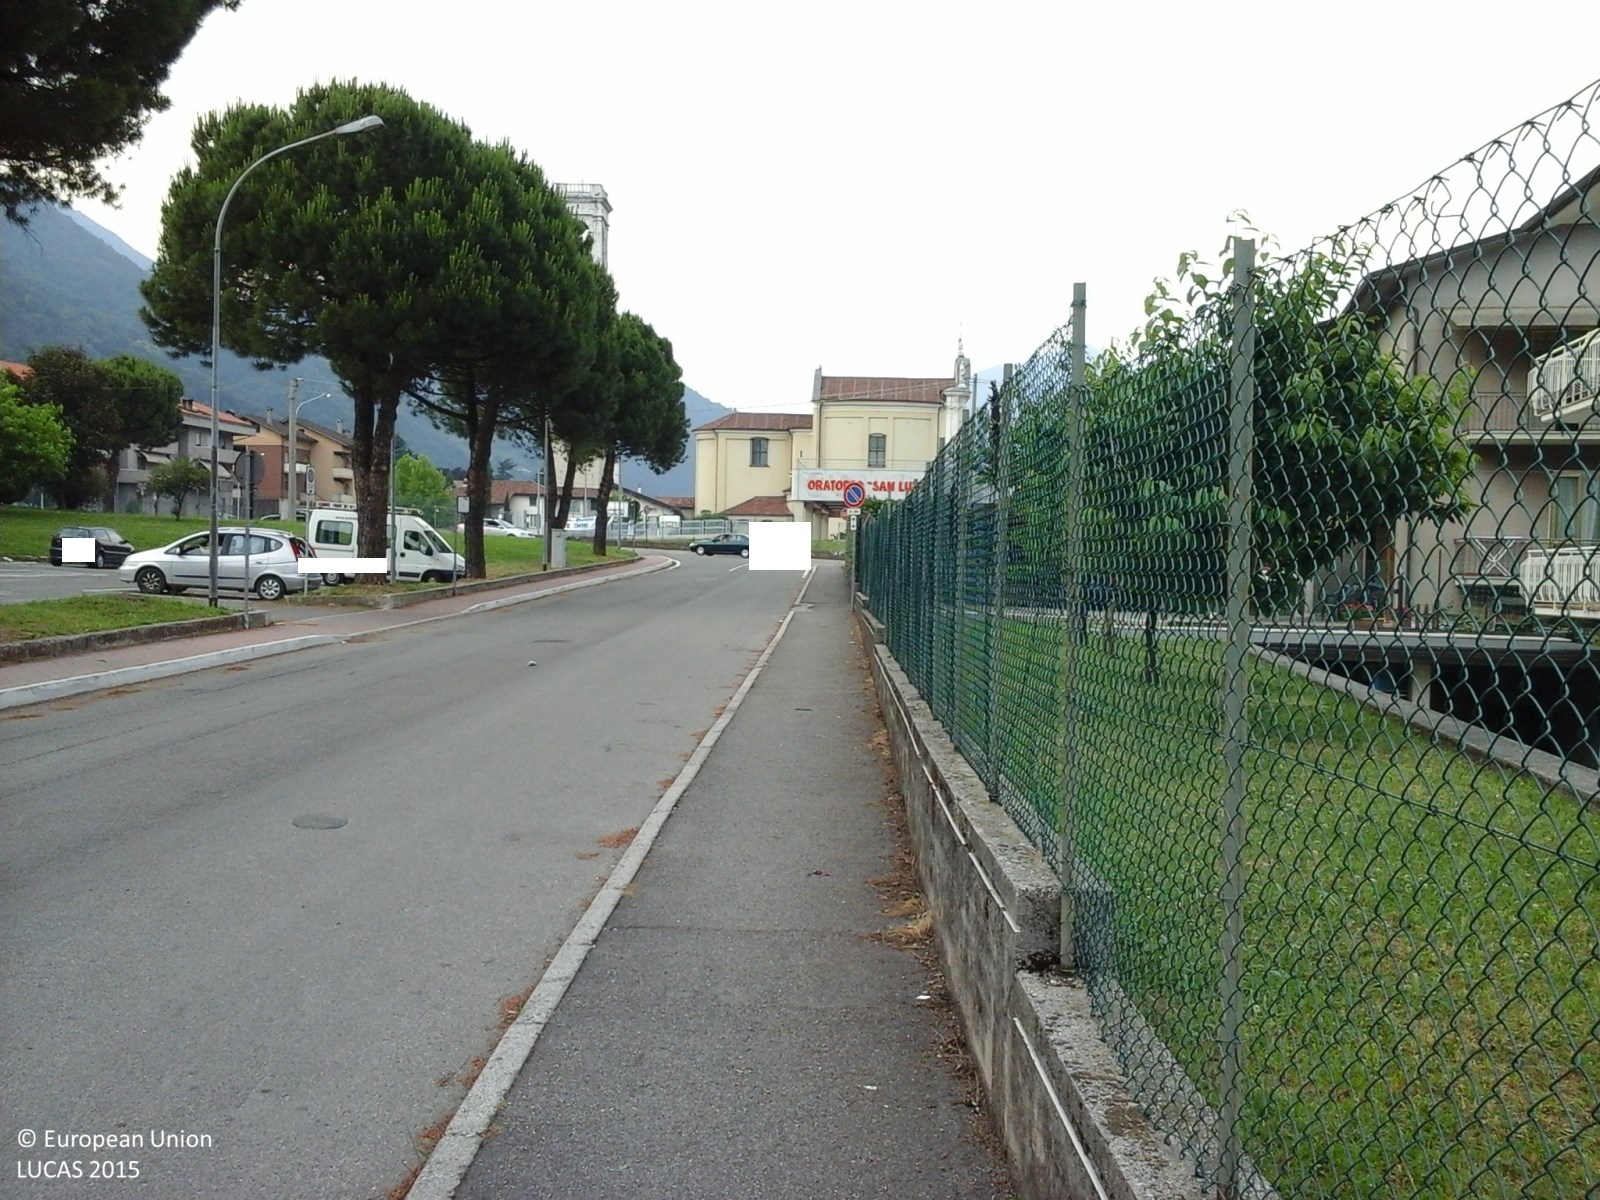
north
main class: Grassland
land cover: Grassland with sparse tree/shrub cover
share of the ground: > 75 %
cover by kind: herbaceous plants 95 %, coniferous forest trees 5 %
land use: Residential
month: June
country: IT
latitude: 45.6304
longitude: 10.1921
